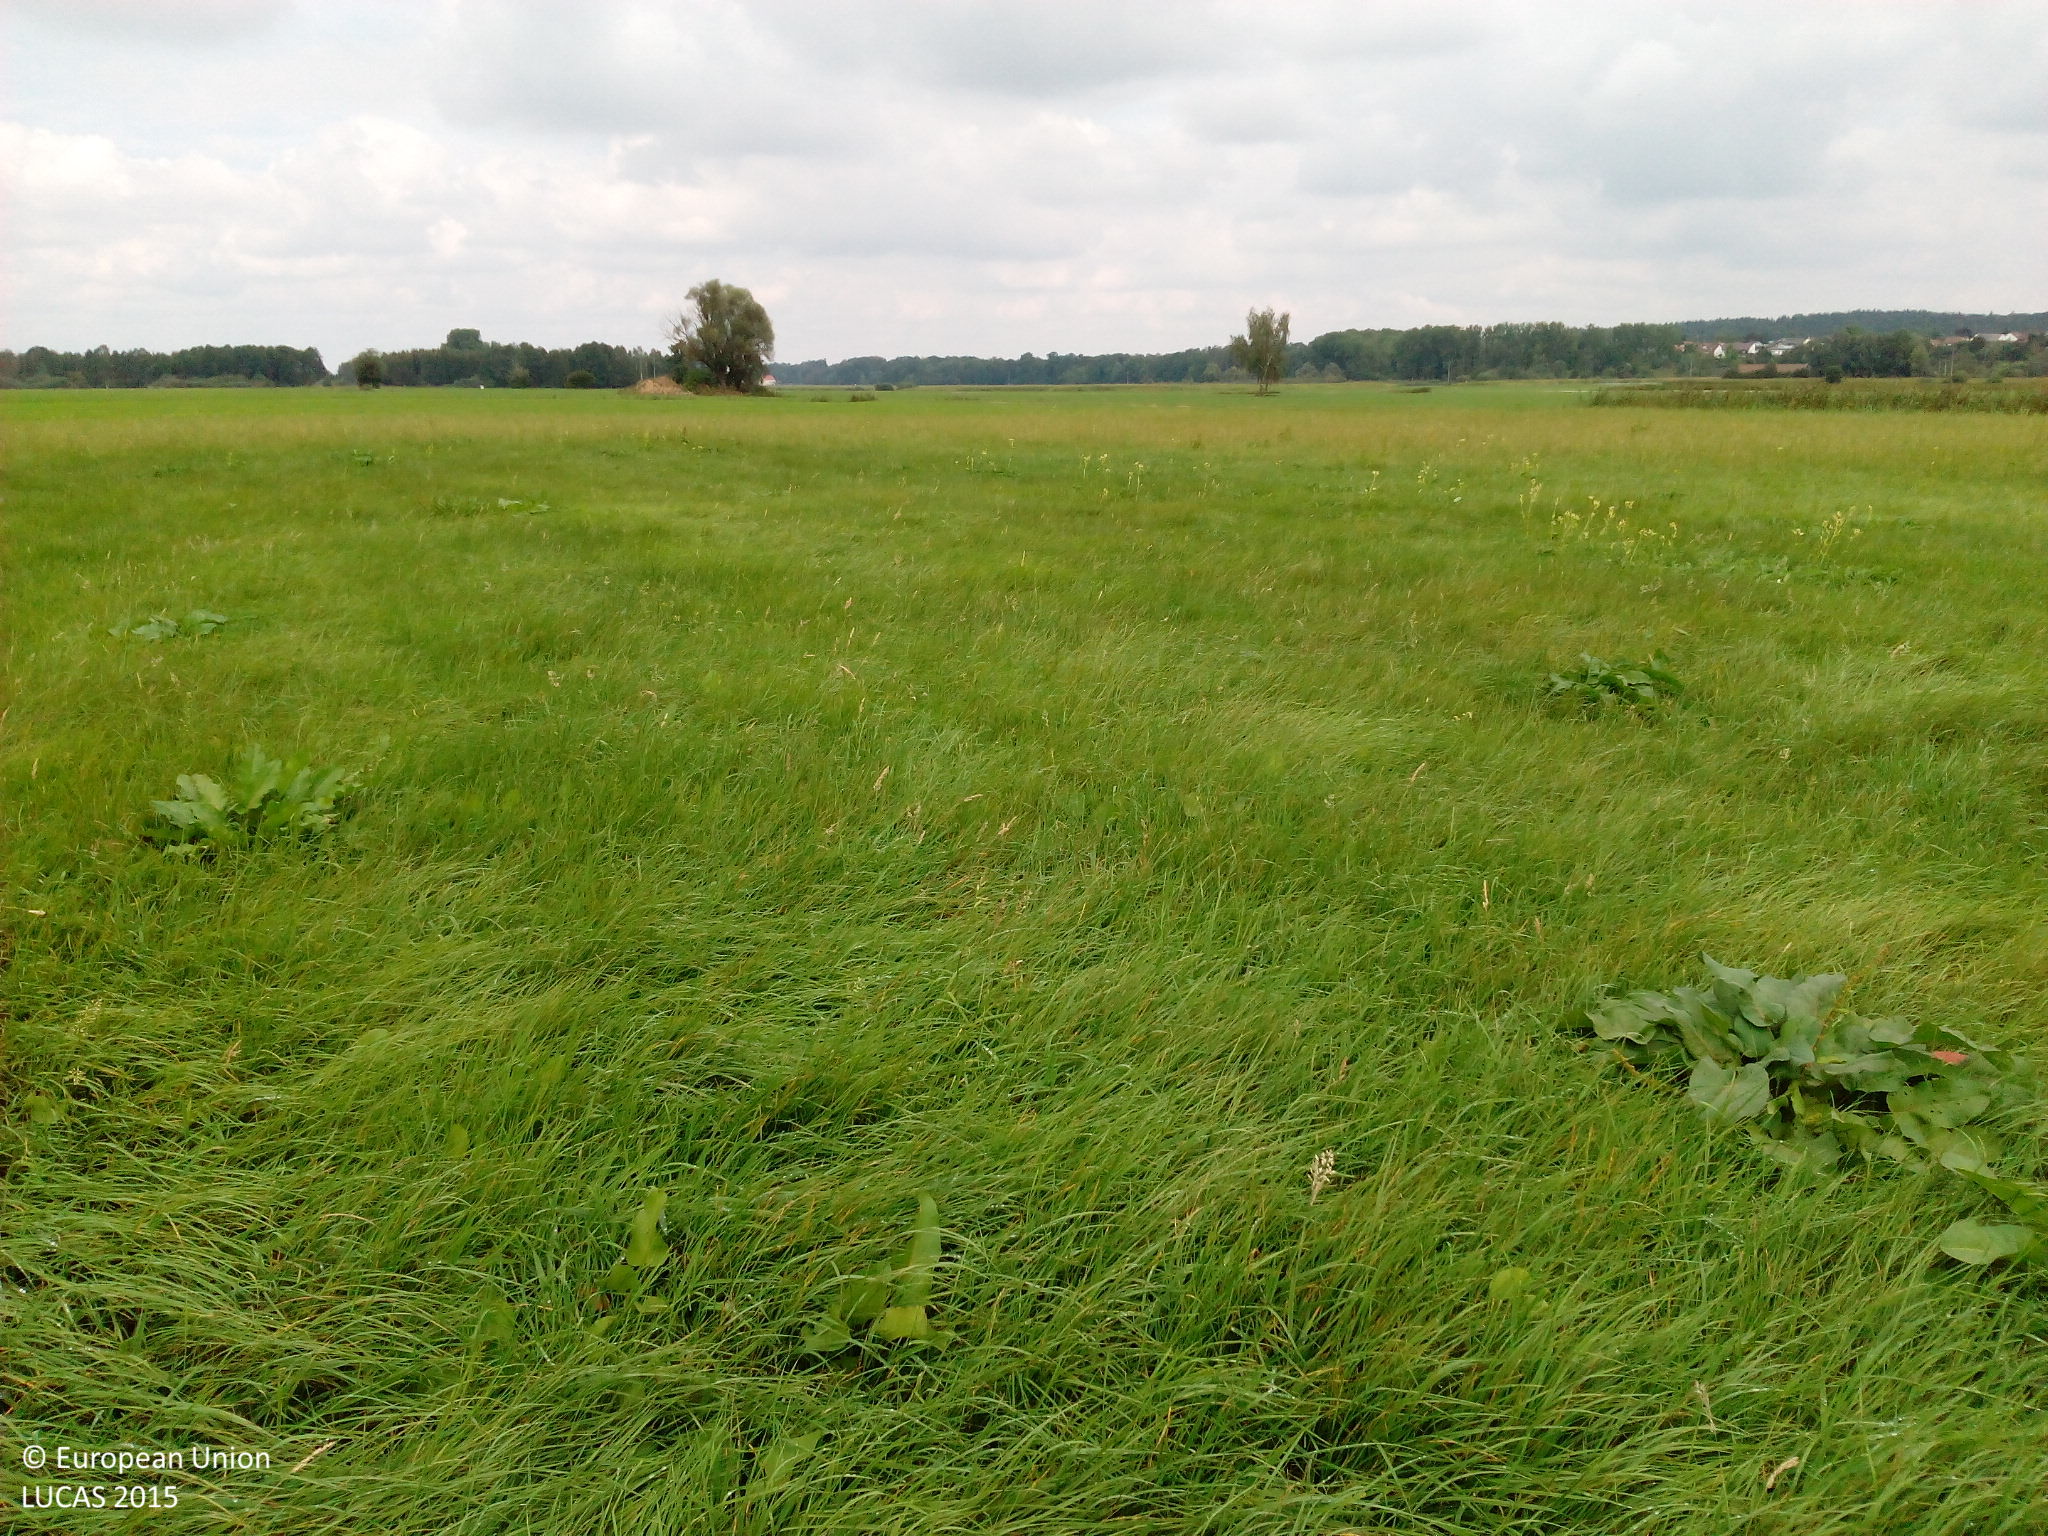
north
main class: Grassland
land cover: Grassland without tree/shrub cover
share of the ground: > 75 %
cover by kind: herbaceous plants 100 %
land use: Agriculture (excluding fallow land and kitchen gardens)
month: September
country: DE
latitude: 48.3311
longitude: 10.3101
